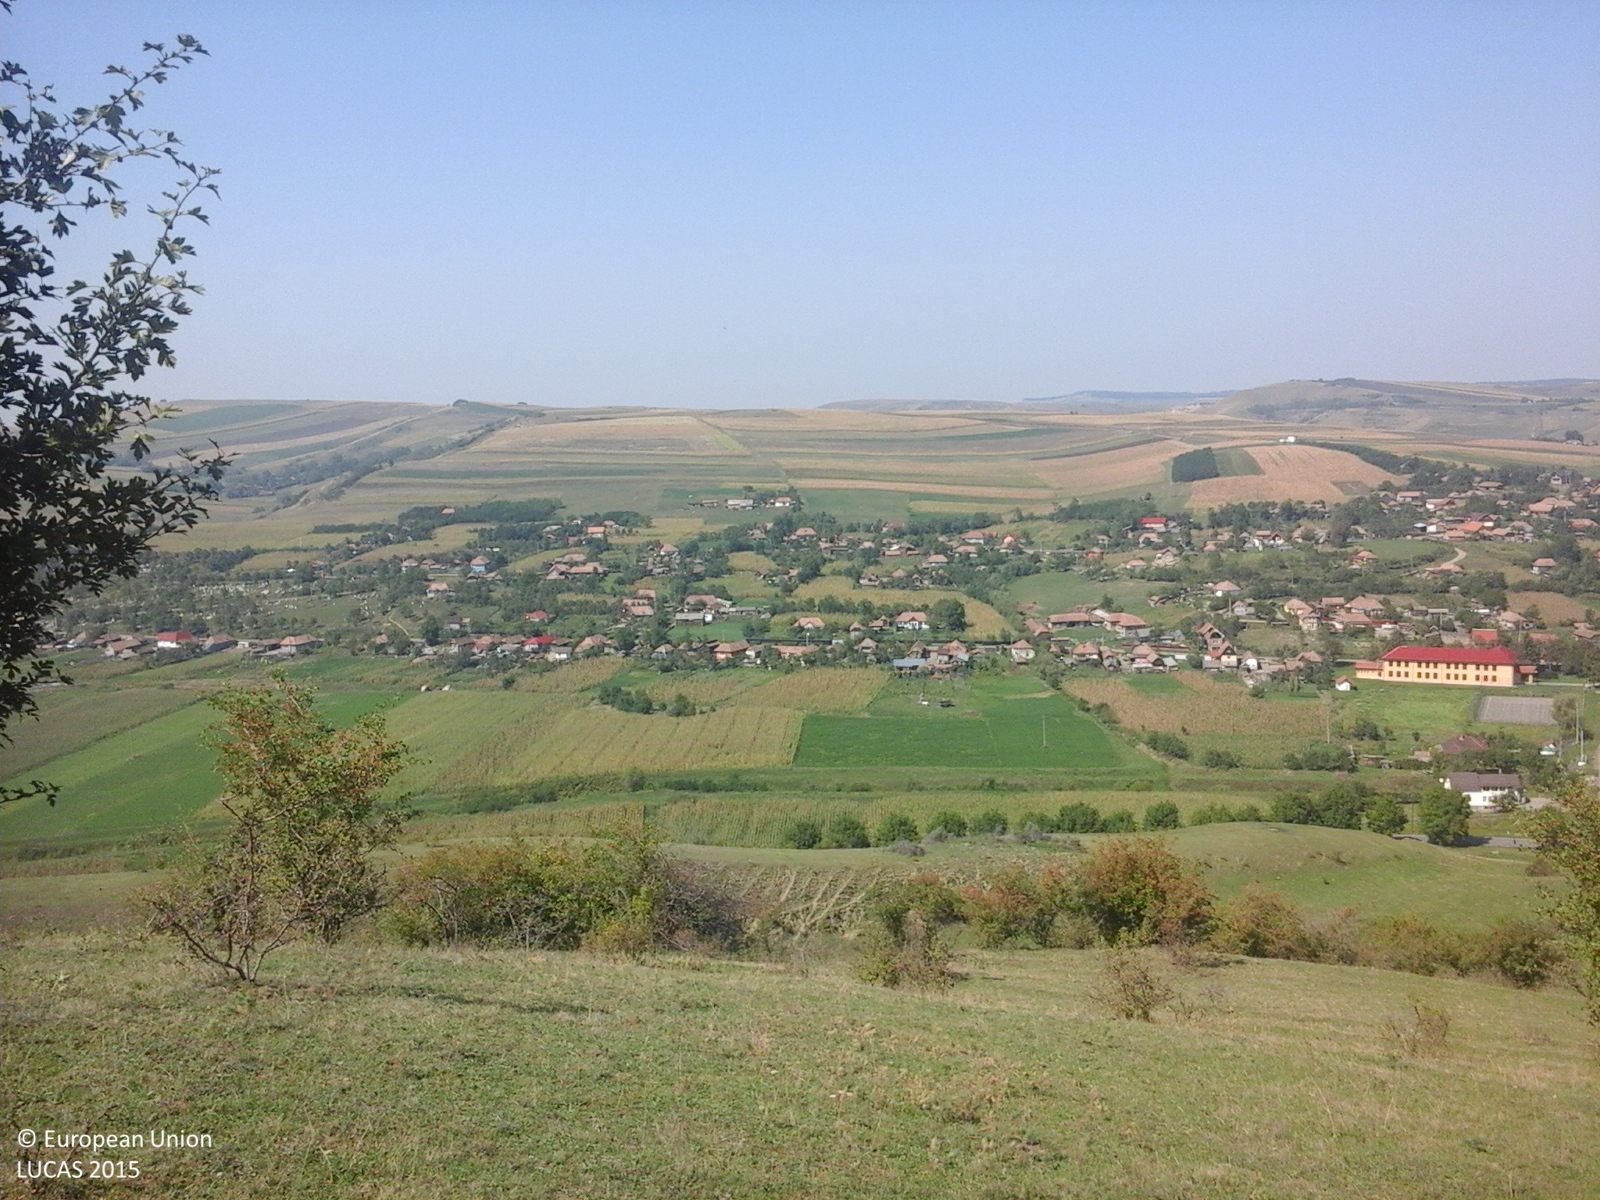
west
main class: Grassland
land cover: Grassland with sparse tree/shrub cover
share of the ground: > 75 %
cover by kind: herbaceous plants 95 %, broadleaved forest trees 5 %
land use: Fallow land
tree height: < 5 m
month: September
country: RO
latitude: 46.7217
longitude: 24.4129
